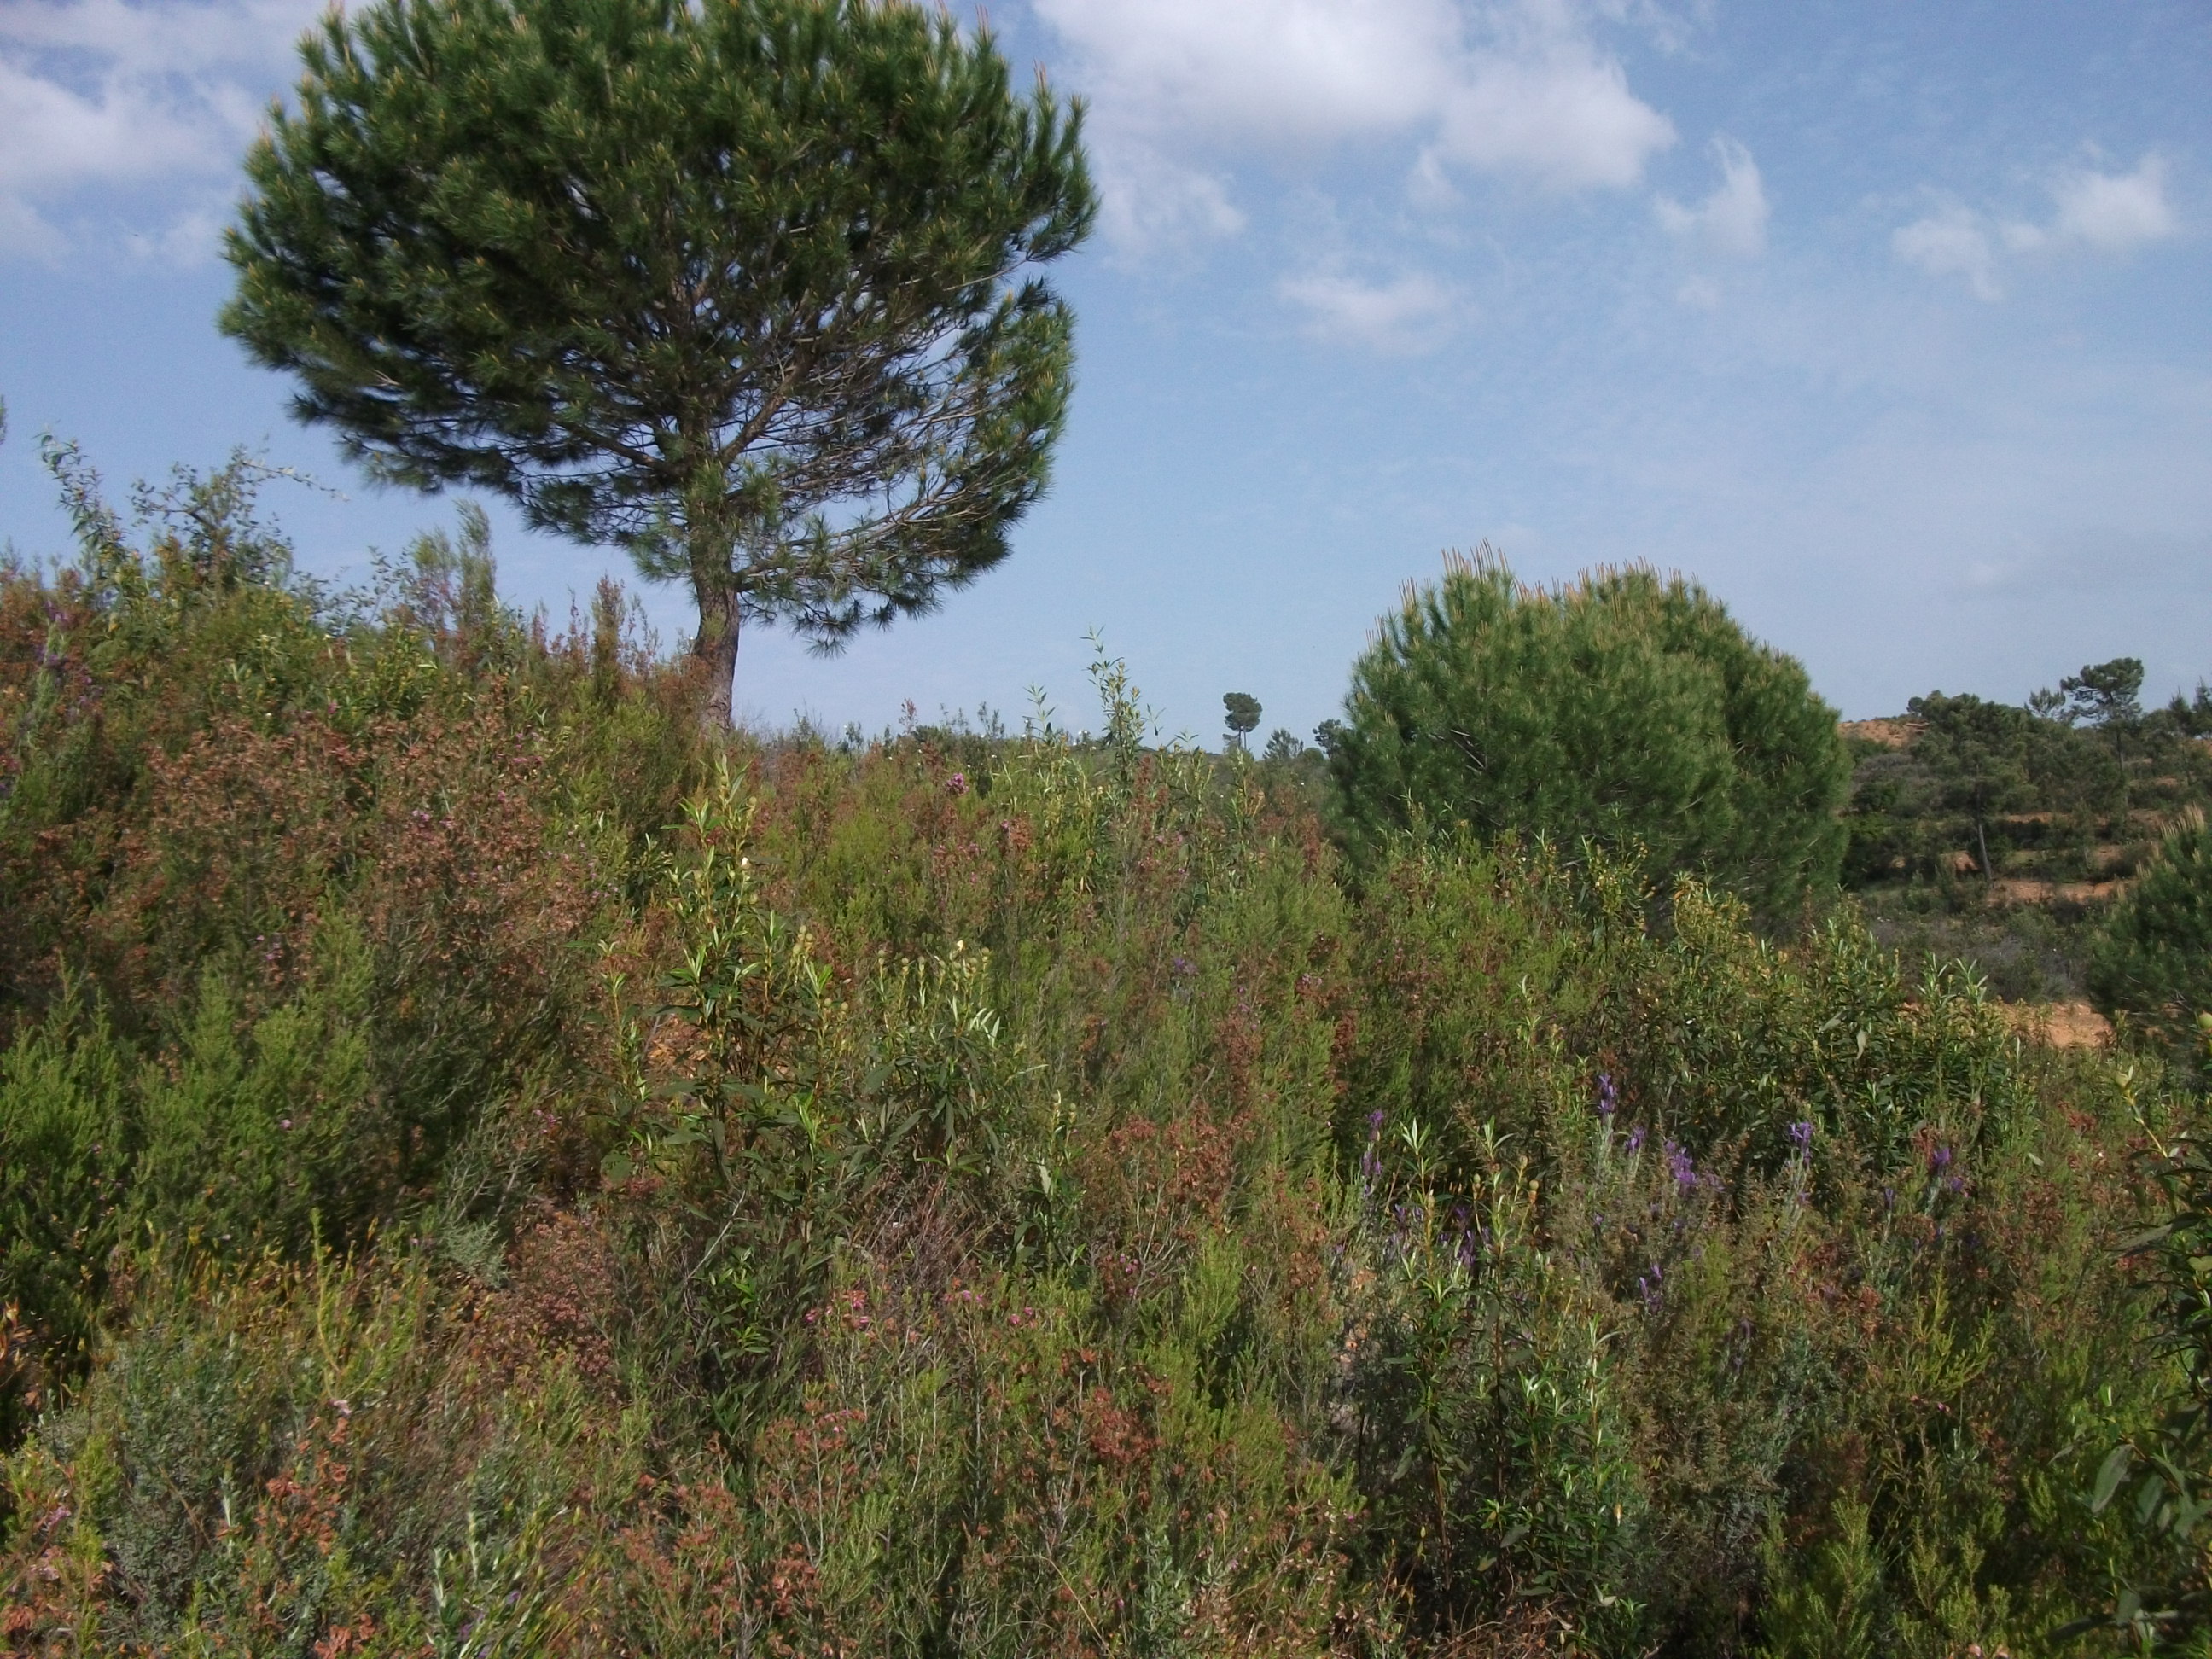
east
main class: Woodland
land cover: Pine dominated coniferous woodland
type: coniferous forest of the mediterranean region
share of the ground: 50 - 75 %
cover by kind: coniferous forest trees 70 %, shrubs 30 %
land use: Forestry
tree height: > 5 m
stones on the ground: 10 - 25 %
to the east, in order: Pine dominated coniferous woodland; Other structural elements; Shrubland without tree cover; Broadleaved woodland; Pine dominated coniferous woodland; Shrubland without tree cover
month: April
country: ES
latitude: 37.7952
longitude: -6.6809
